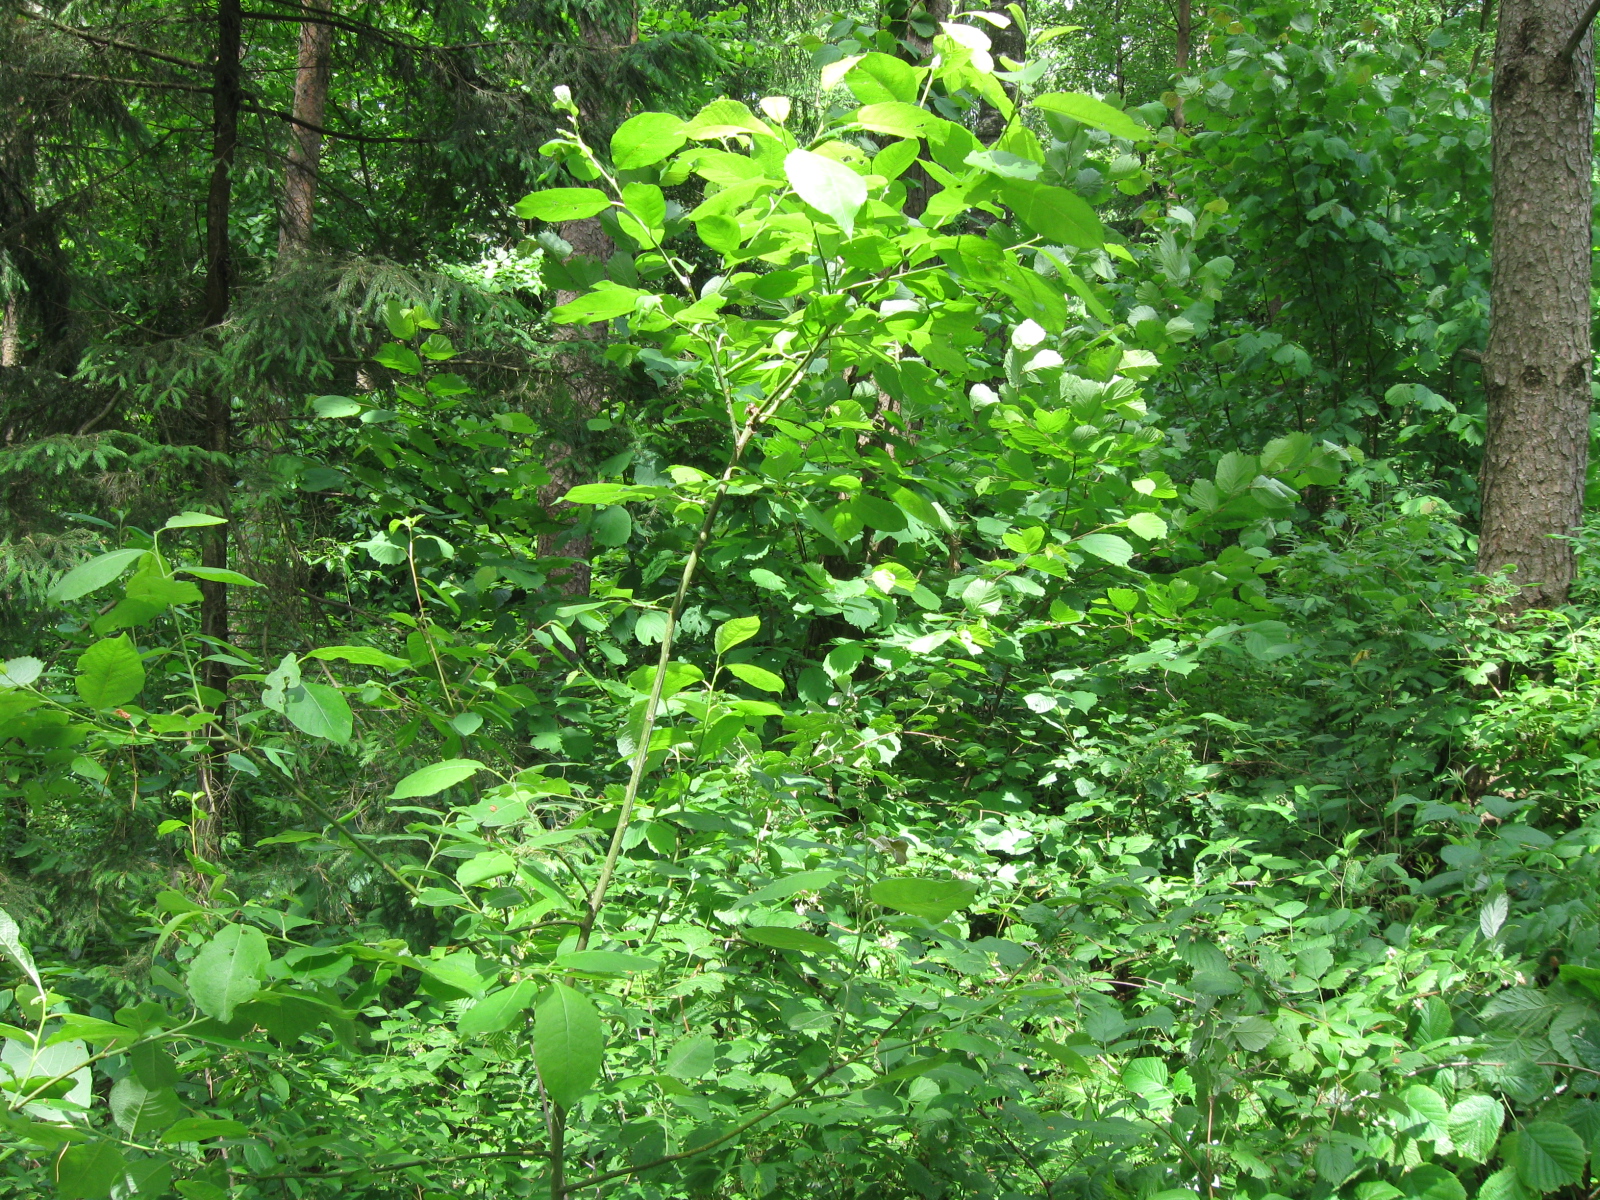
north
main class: Woodland
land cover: Pine dominated mixed woodland
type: hemiboreal forest and nemoral coniferous forest and mixed broadleaved-coniferous forest
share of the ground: > 75 %
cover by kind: coniferous forest trees 65 %, broadleaved forest trees 30 %, herbaceous plants 5 %
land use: Forestry
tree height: > 5 m
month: June
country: LT
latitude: 54.6305
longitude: 24.4618
